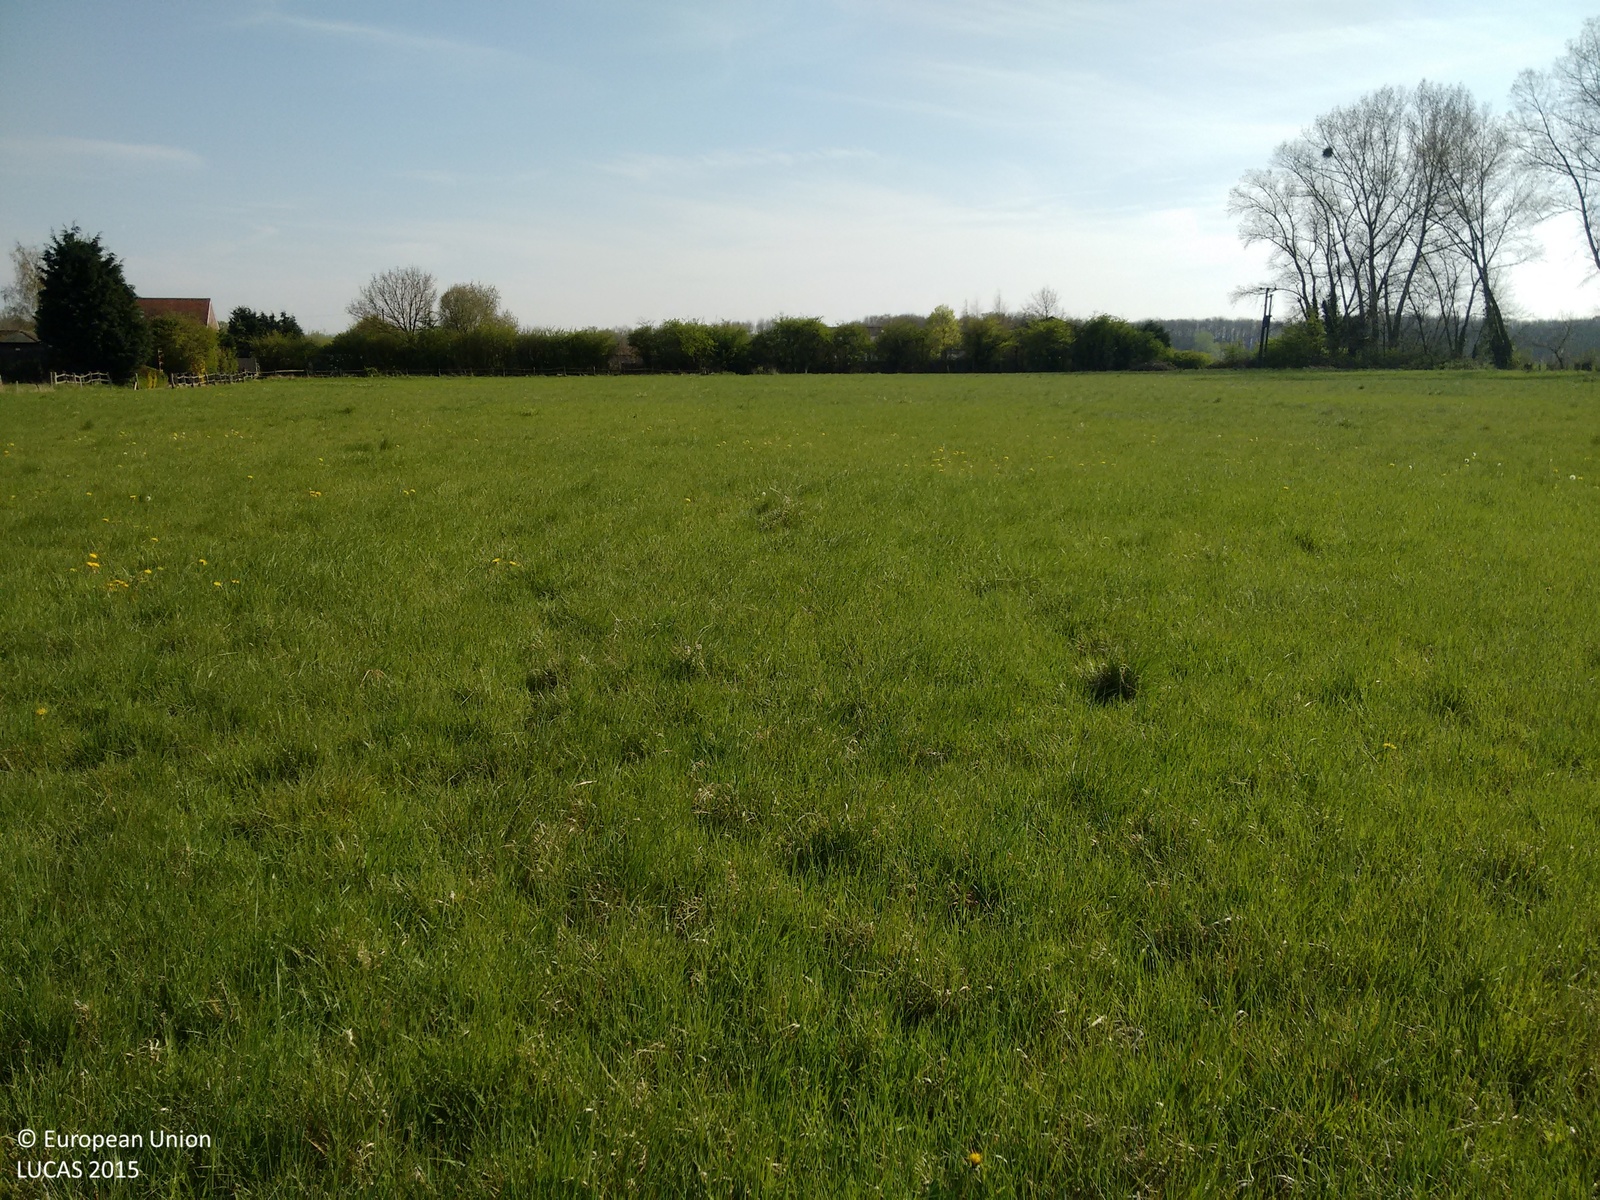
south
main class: Grassland
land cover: Grassland without tree/shrub cover
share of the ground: > 75 %
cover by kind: herbaceous plants 100 %
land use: Agriculture (excluding fallow land and kitchen gardens)
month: April
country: GB
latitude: 51.2062
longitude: 0.3666
